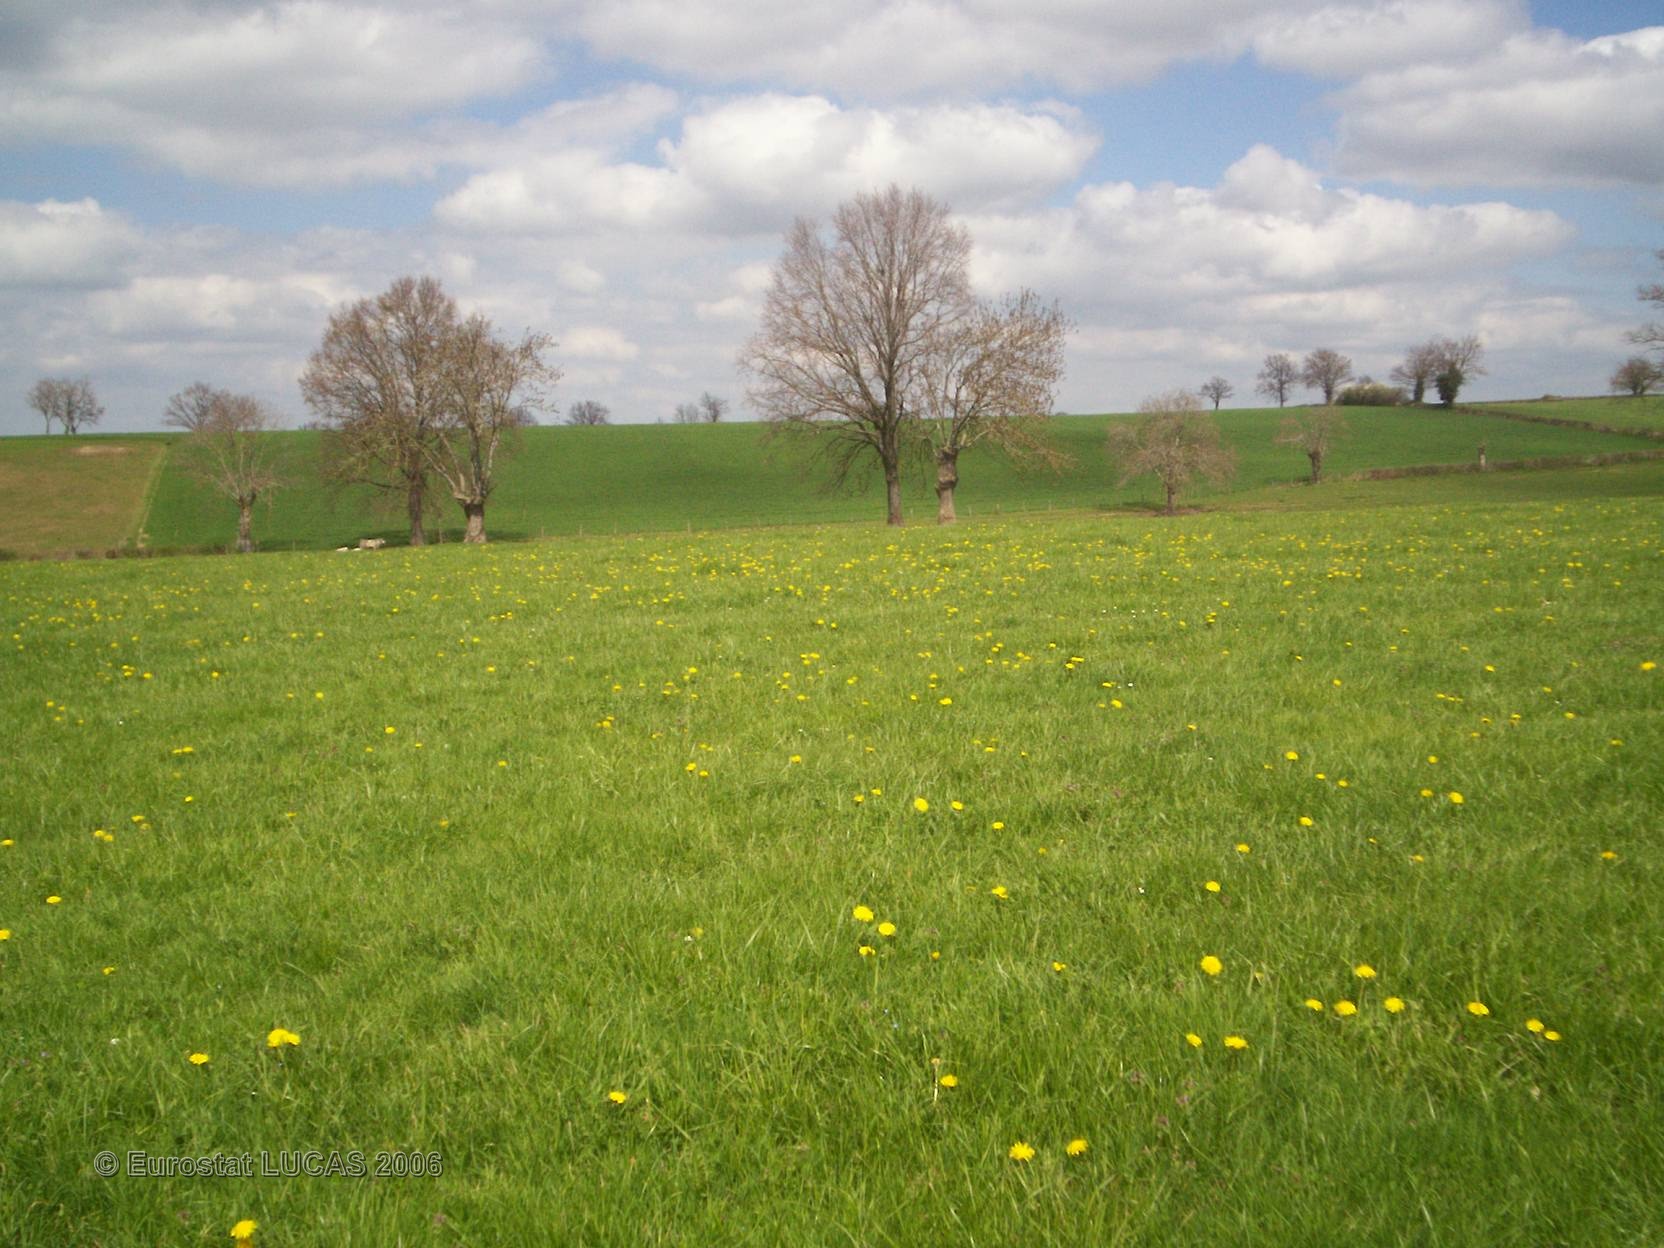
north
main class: Grassland
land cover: Grassland without tree/shrub cover
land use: Agriculture (excluding fallow land and kitchen gardens)
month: April
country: FR
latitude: 46.4655
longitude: 3.0044
